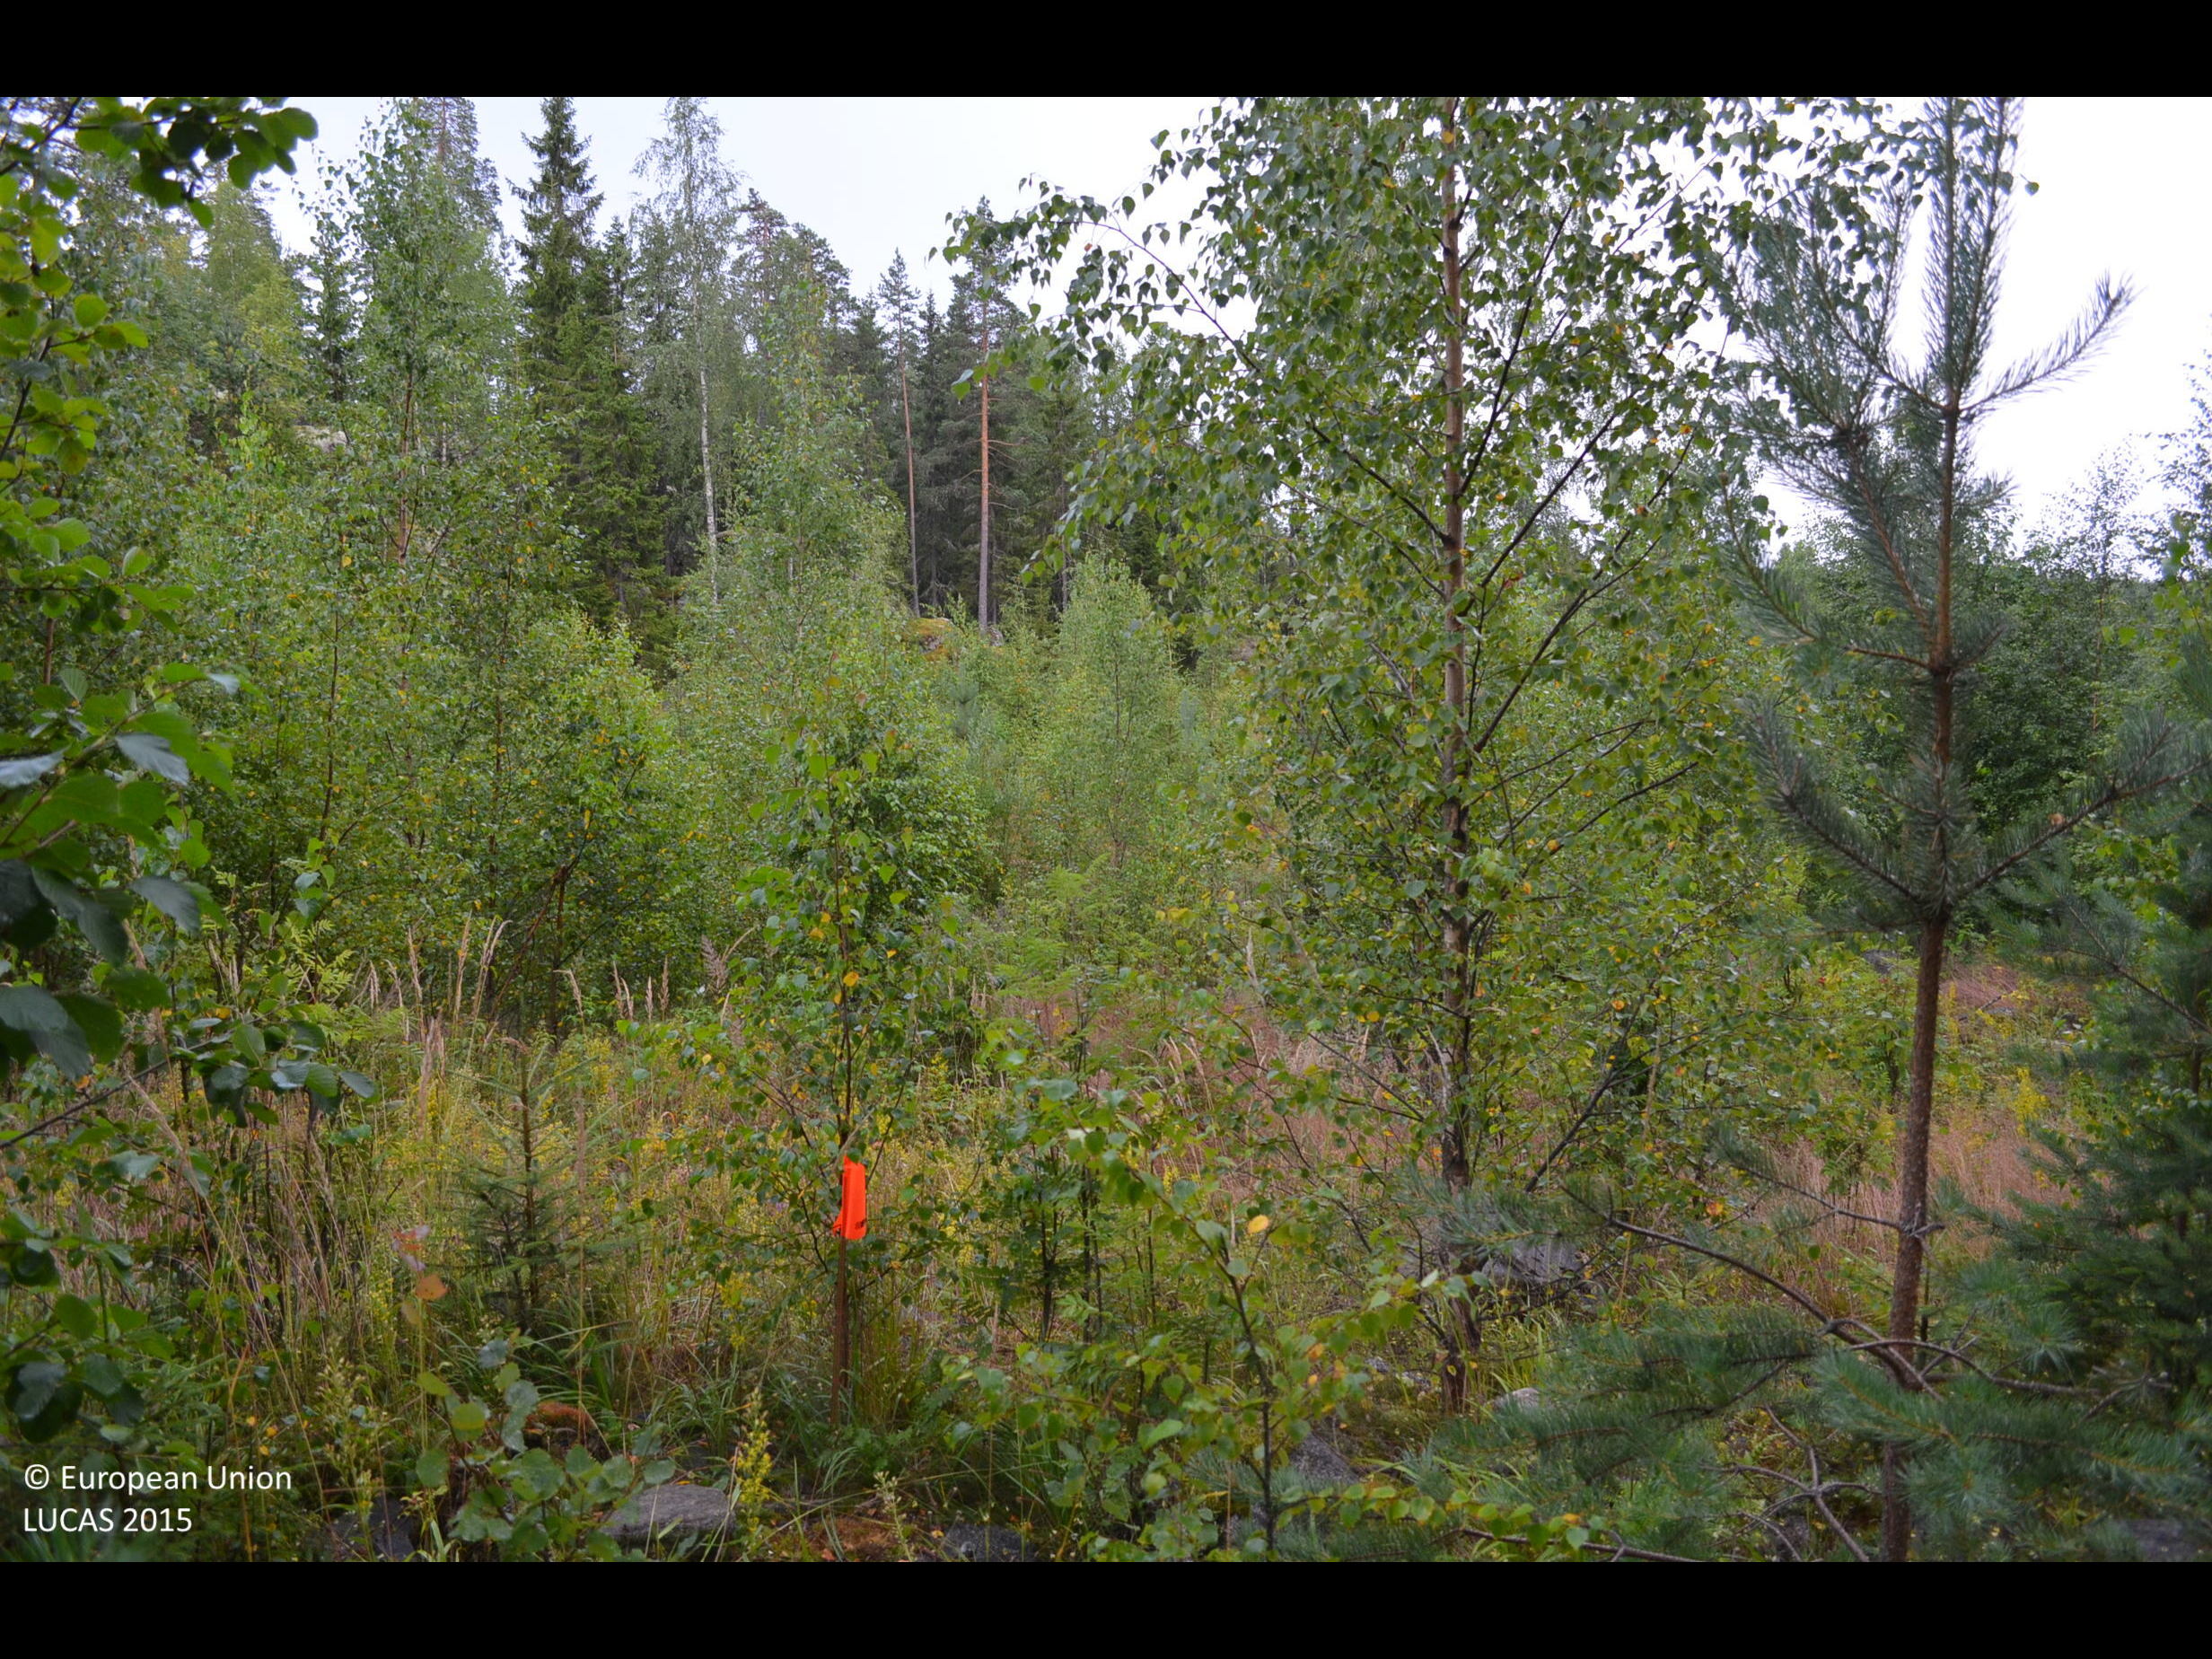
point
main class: Woodland
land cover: Broadleaved woodland
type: boreal forest
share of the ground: 50 - 75 %
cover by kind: broadleaved forest trees 45 %, herbaceous plants 20 %, consolidated bare surface 15 %, coniferous forest trees 10 %, shrubs 10 %
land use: Forestry
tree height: < 5 m
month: August
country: FI
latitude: 61.5272
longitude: 23.0648
